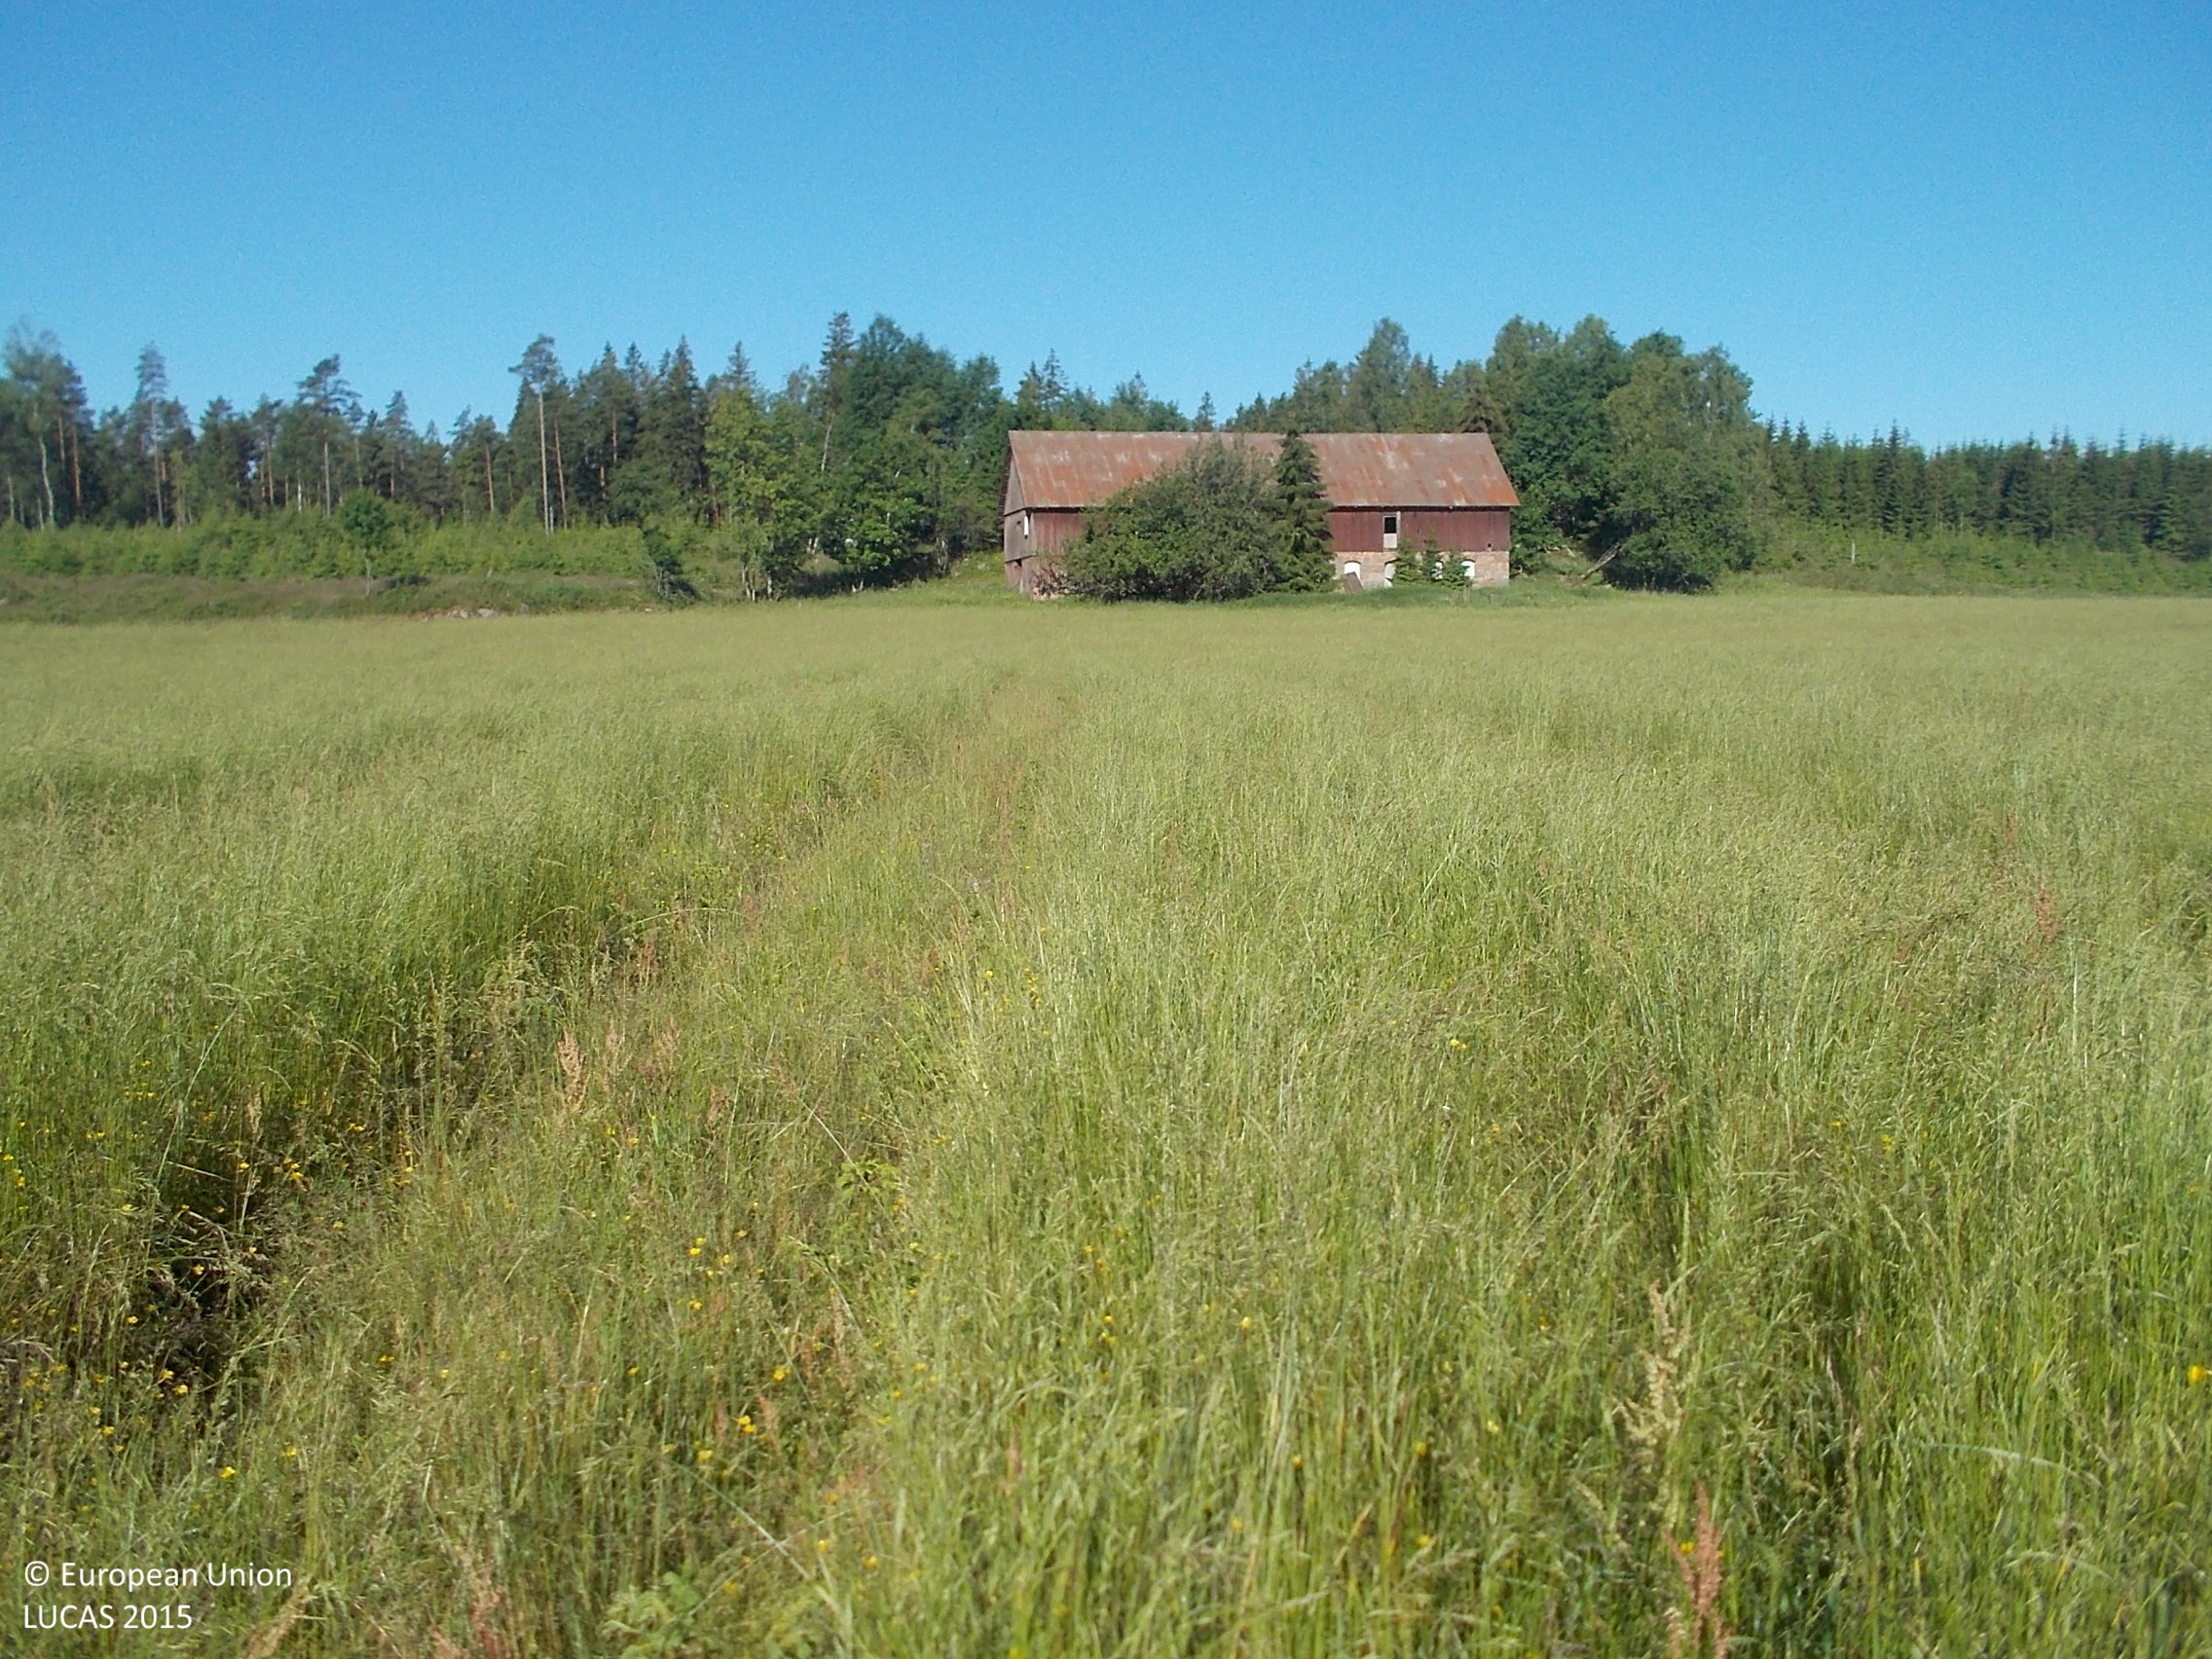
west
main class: Cropland
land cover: Temporary grasslands
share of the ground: > 75 %
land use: Agriculture (excluding fallow land and kitchen gardens)
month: July
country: SE
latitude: 57.2636
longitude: 13.1960
